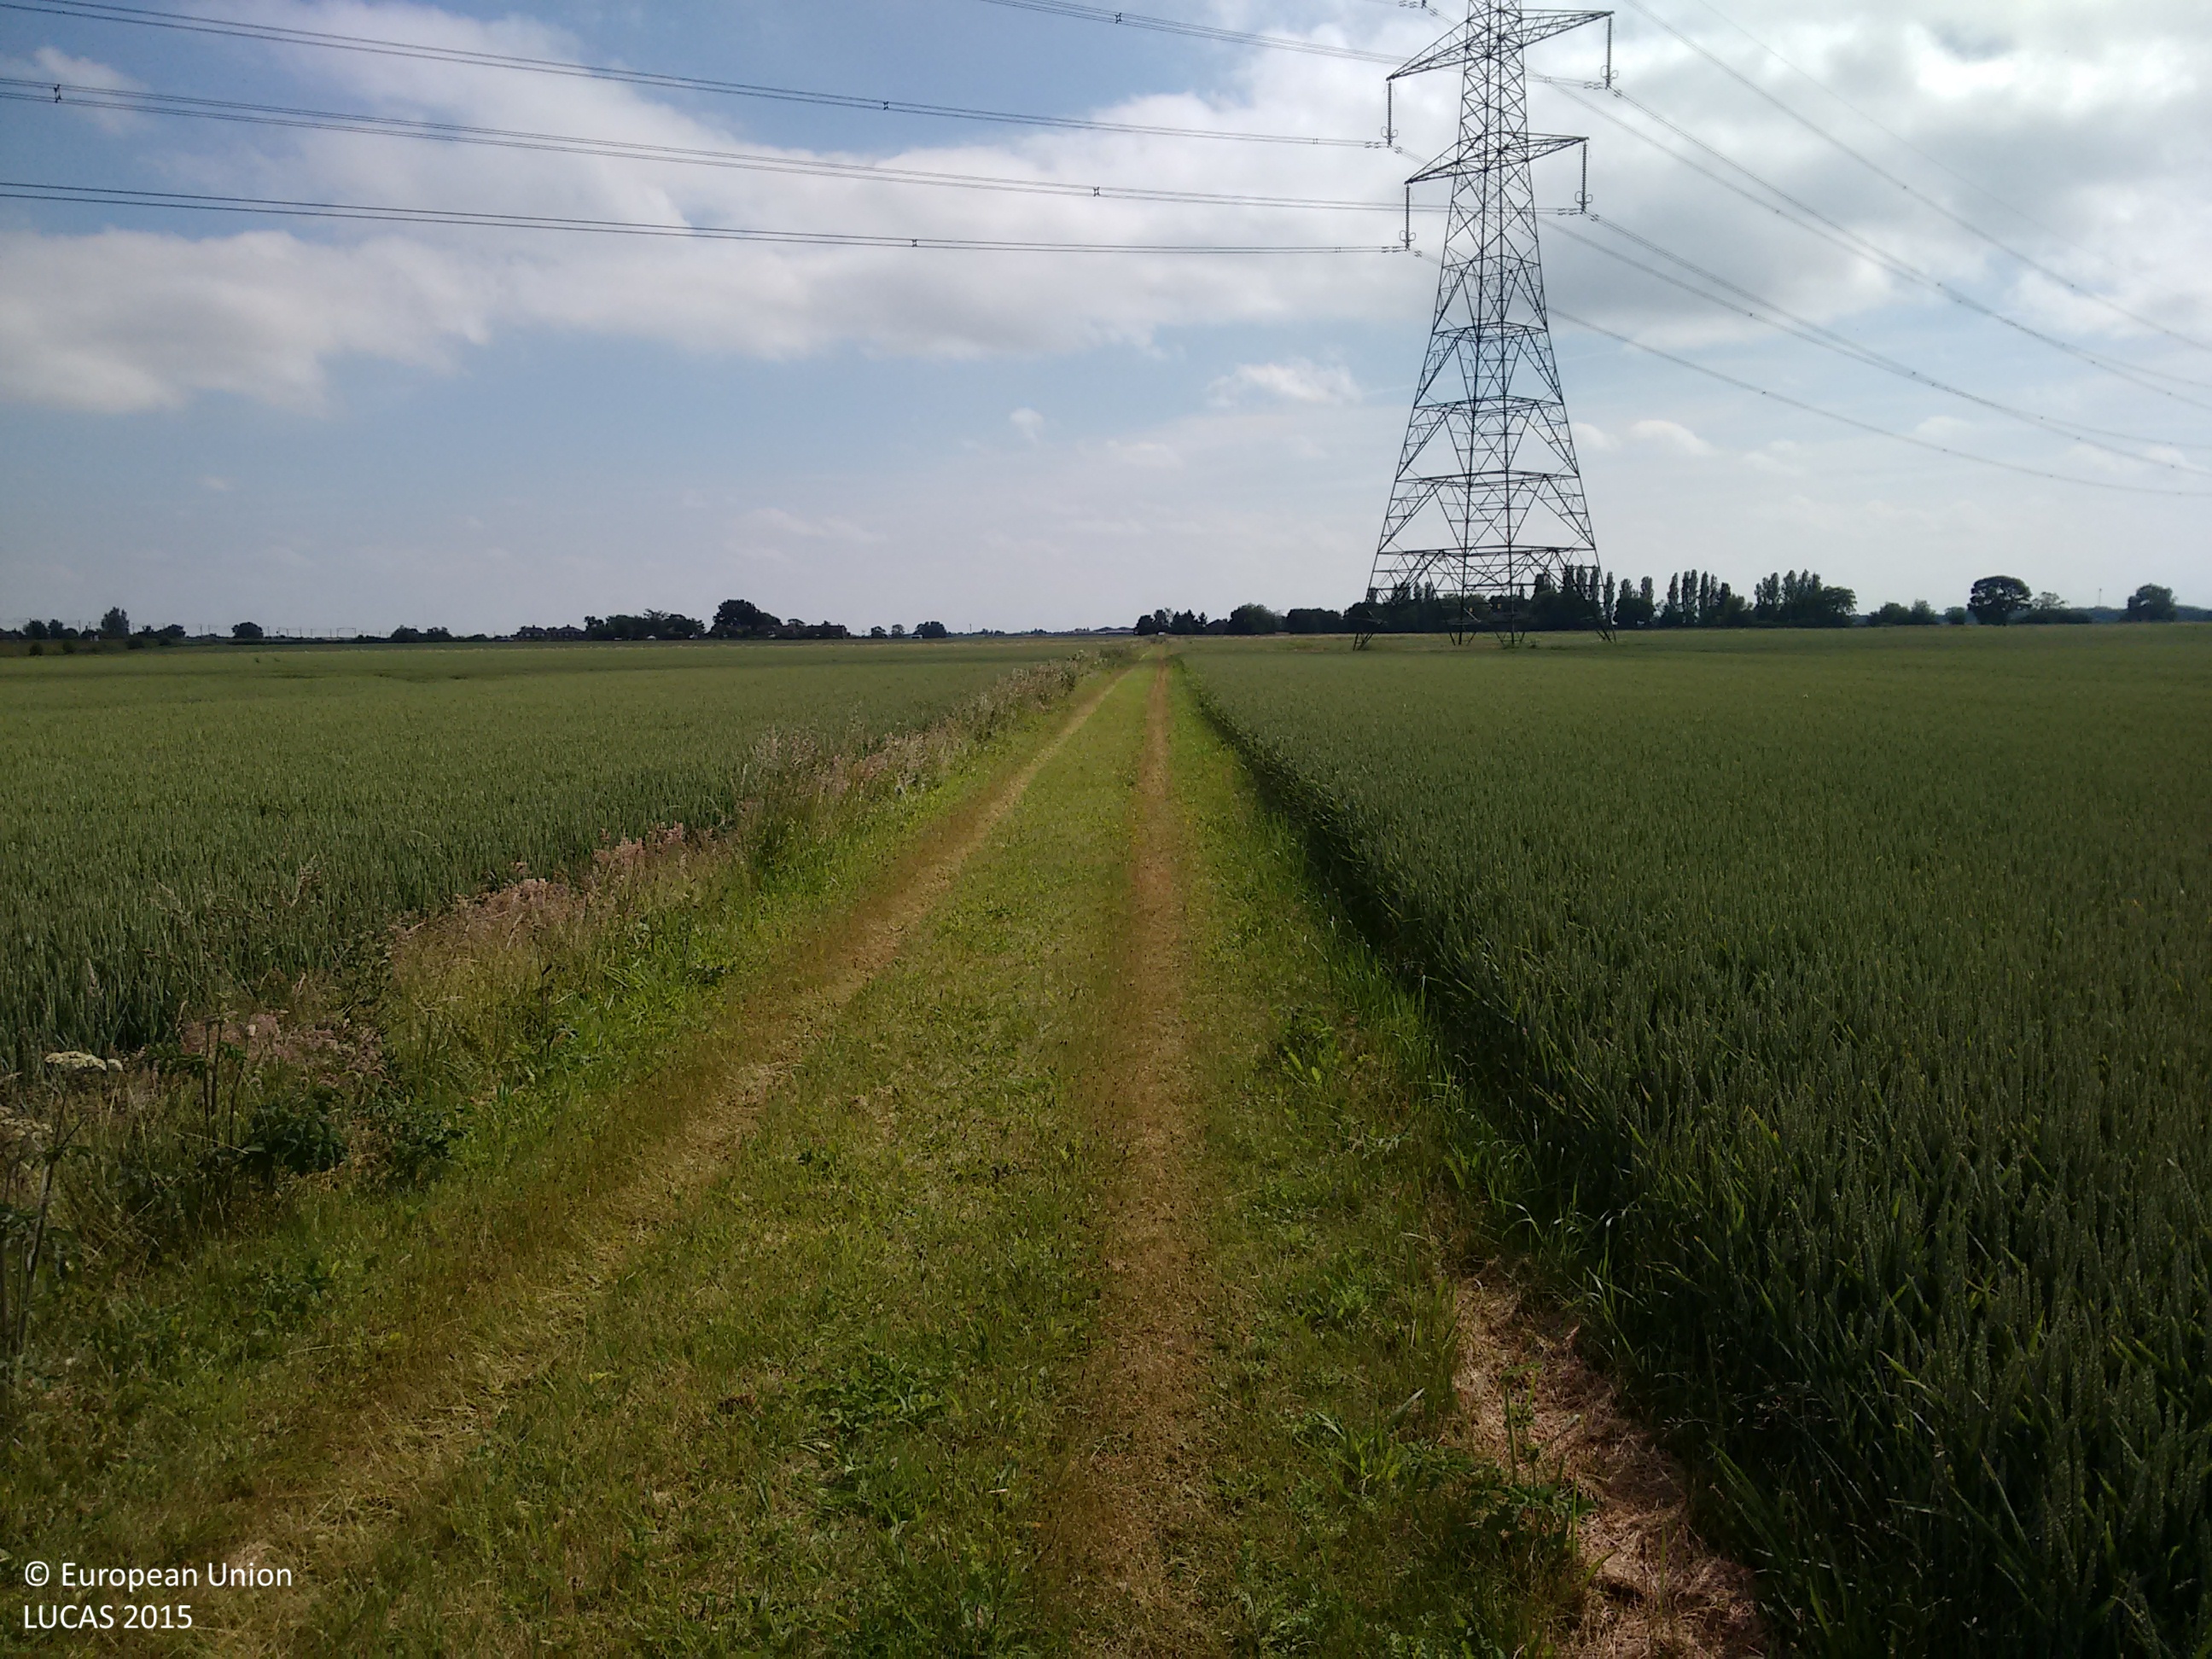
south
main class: Cropland
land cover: Common wheat
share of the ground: > 75 %
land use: Agriculture (excluding fallow land and kitchen gardens)
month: June
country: GB
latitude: 53.7257
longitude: -1.0931
